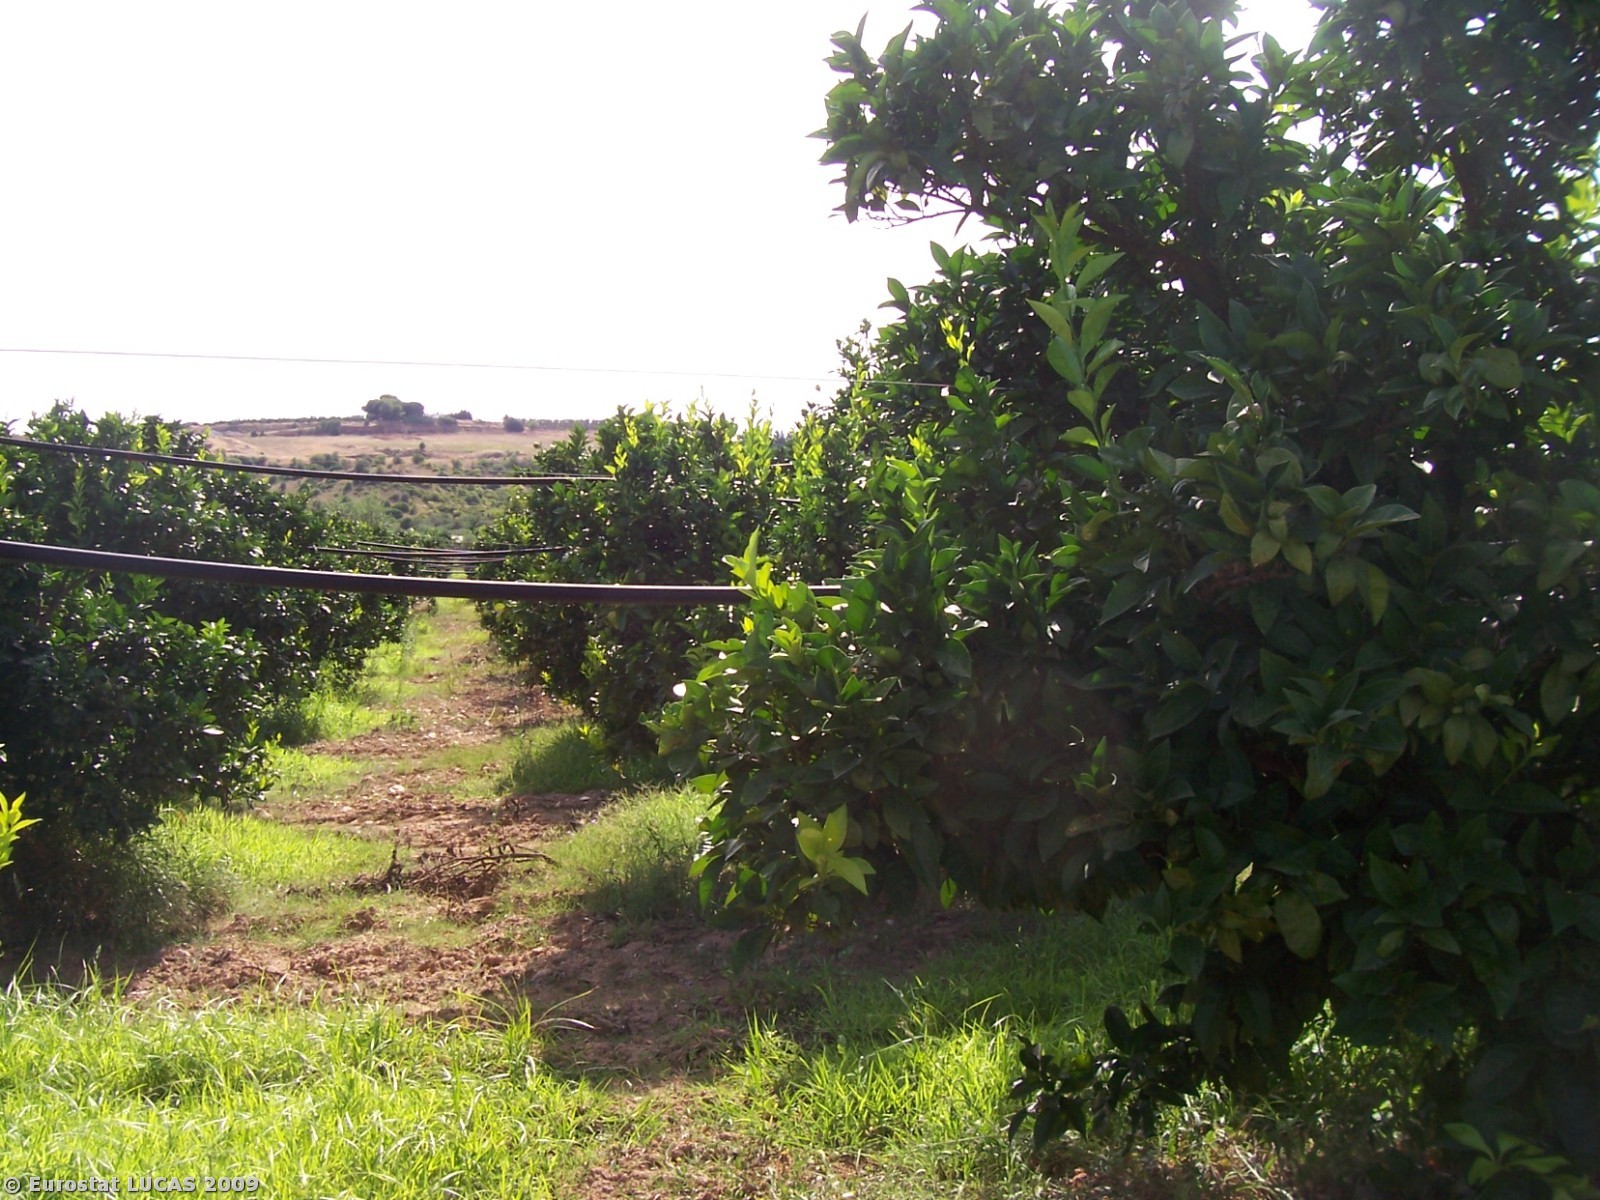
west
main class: Cropland
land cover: Oranges
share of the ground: 50 - 75 %
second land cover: Spontaneously vegetated surfaces
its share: > 75 %
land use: Agriculture (excluding fallow land and kitchen gardens)
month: July
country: IT
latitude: 40.5829
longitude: 16.9585
